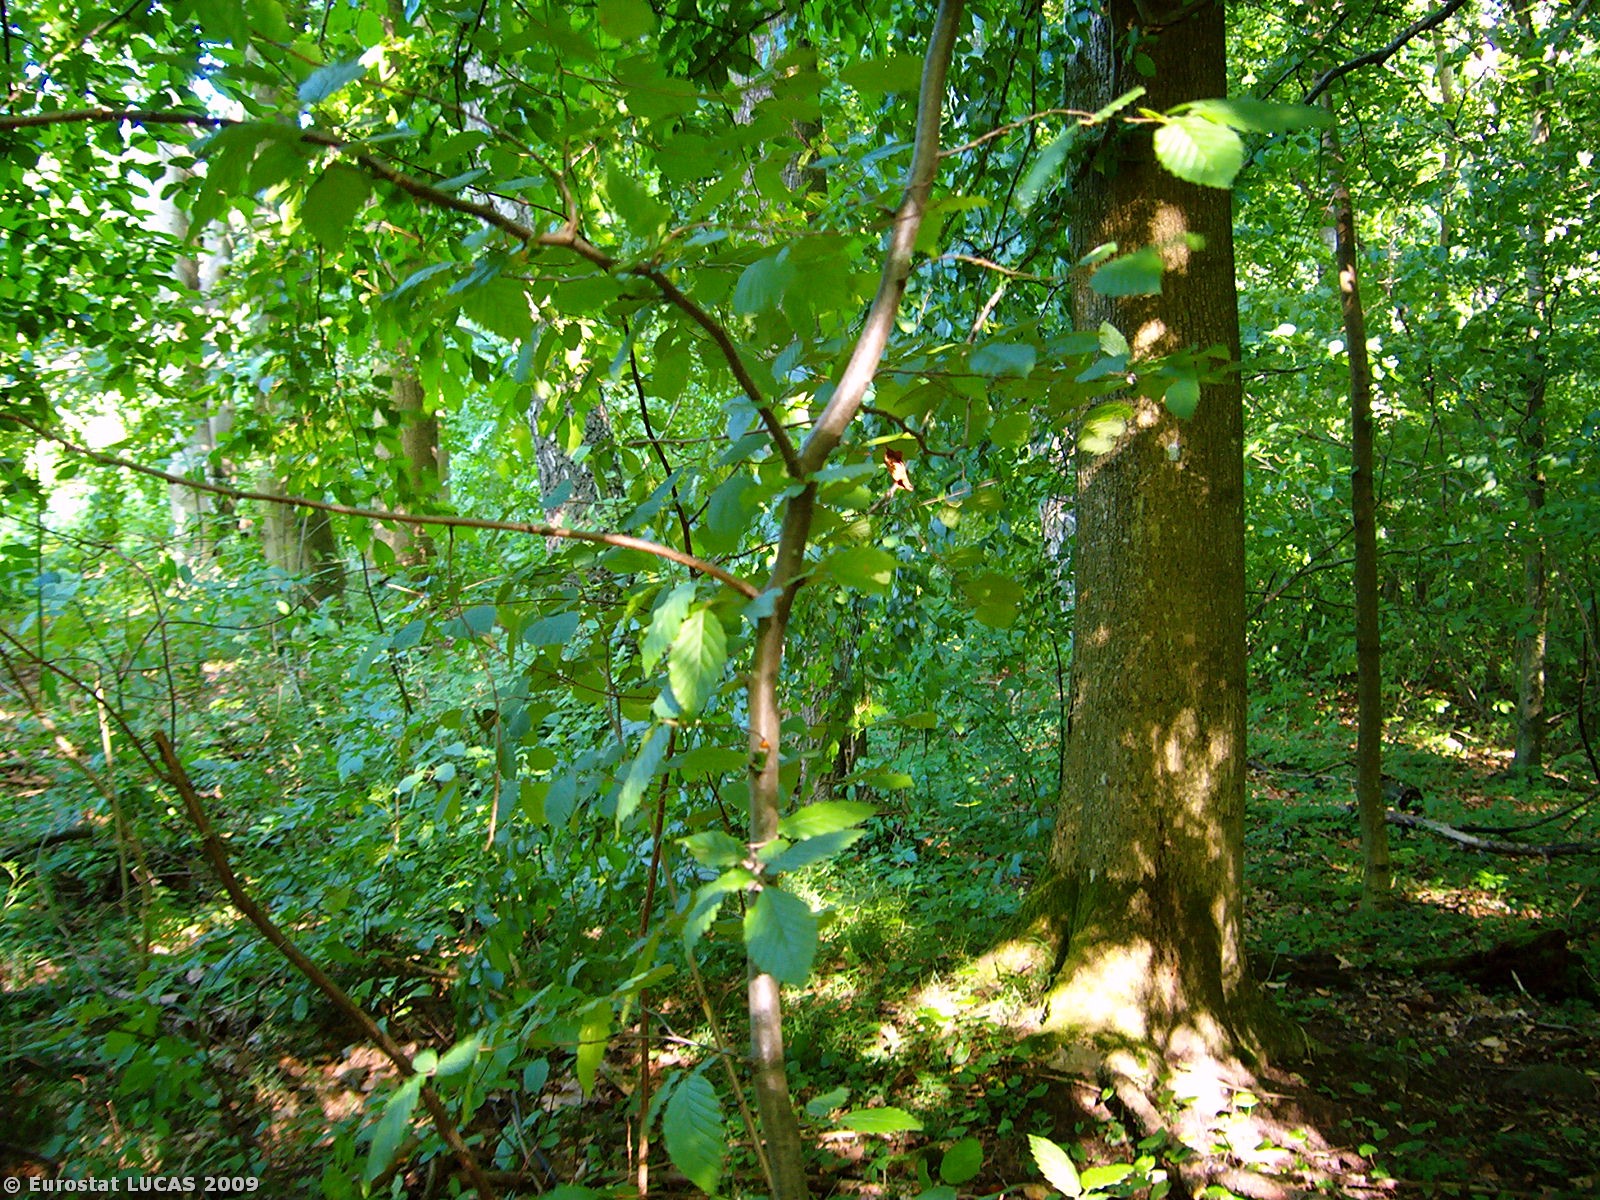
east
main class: Woodland
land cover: Mixed woodland
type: hemiboreal forest and nemoral coniferous forest and mixed broadleaved-coniferous forest
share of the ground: > 75 %
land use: Forestry
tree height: > 5 m
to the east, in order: Mixed woodland; Tracks; Mixed woodland; Ditches and canals; Mixed woodland
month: June
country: PL
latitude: 53.8056
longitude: 15.3630
